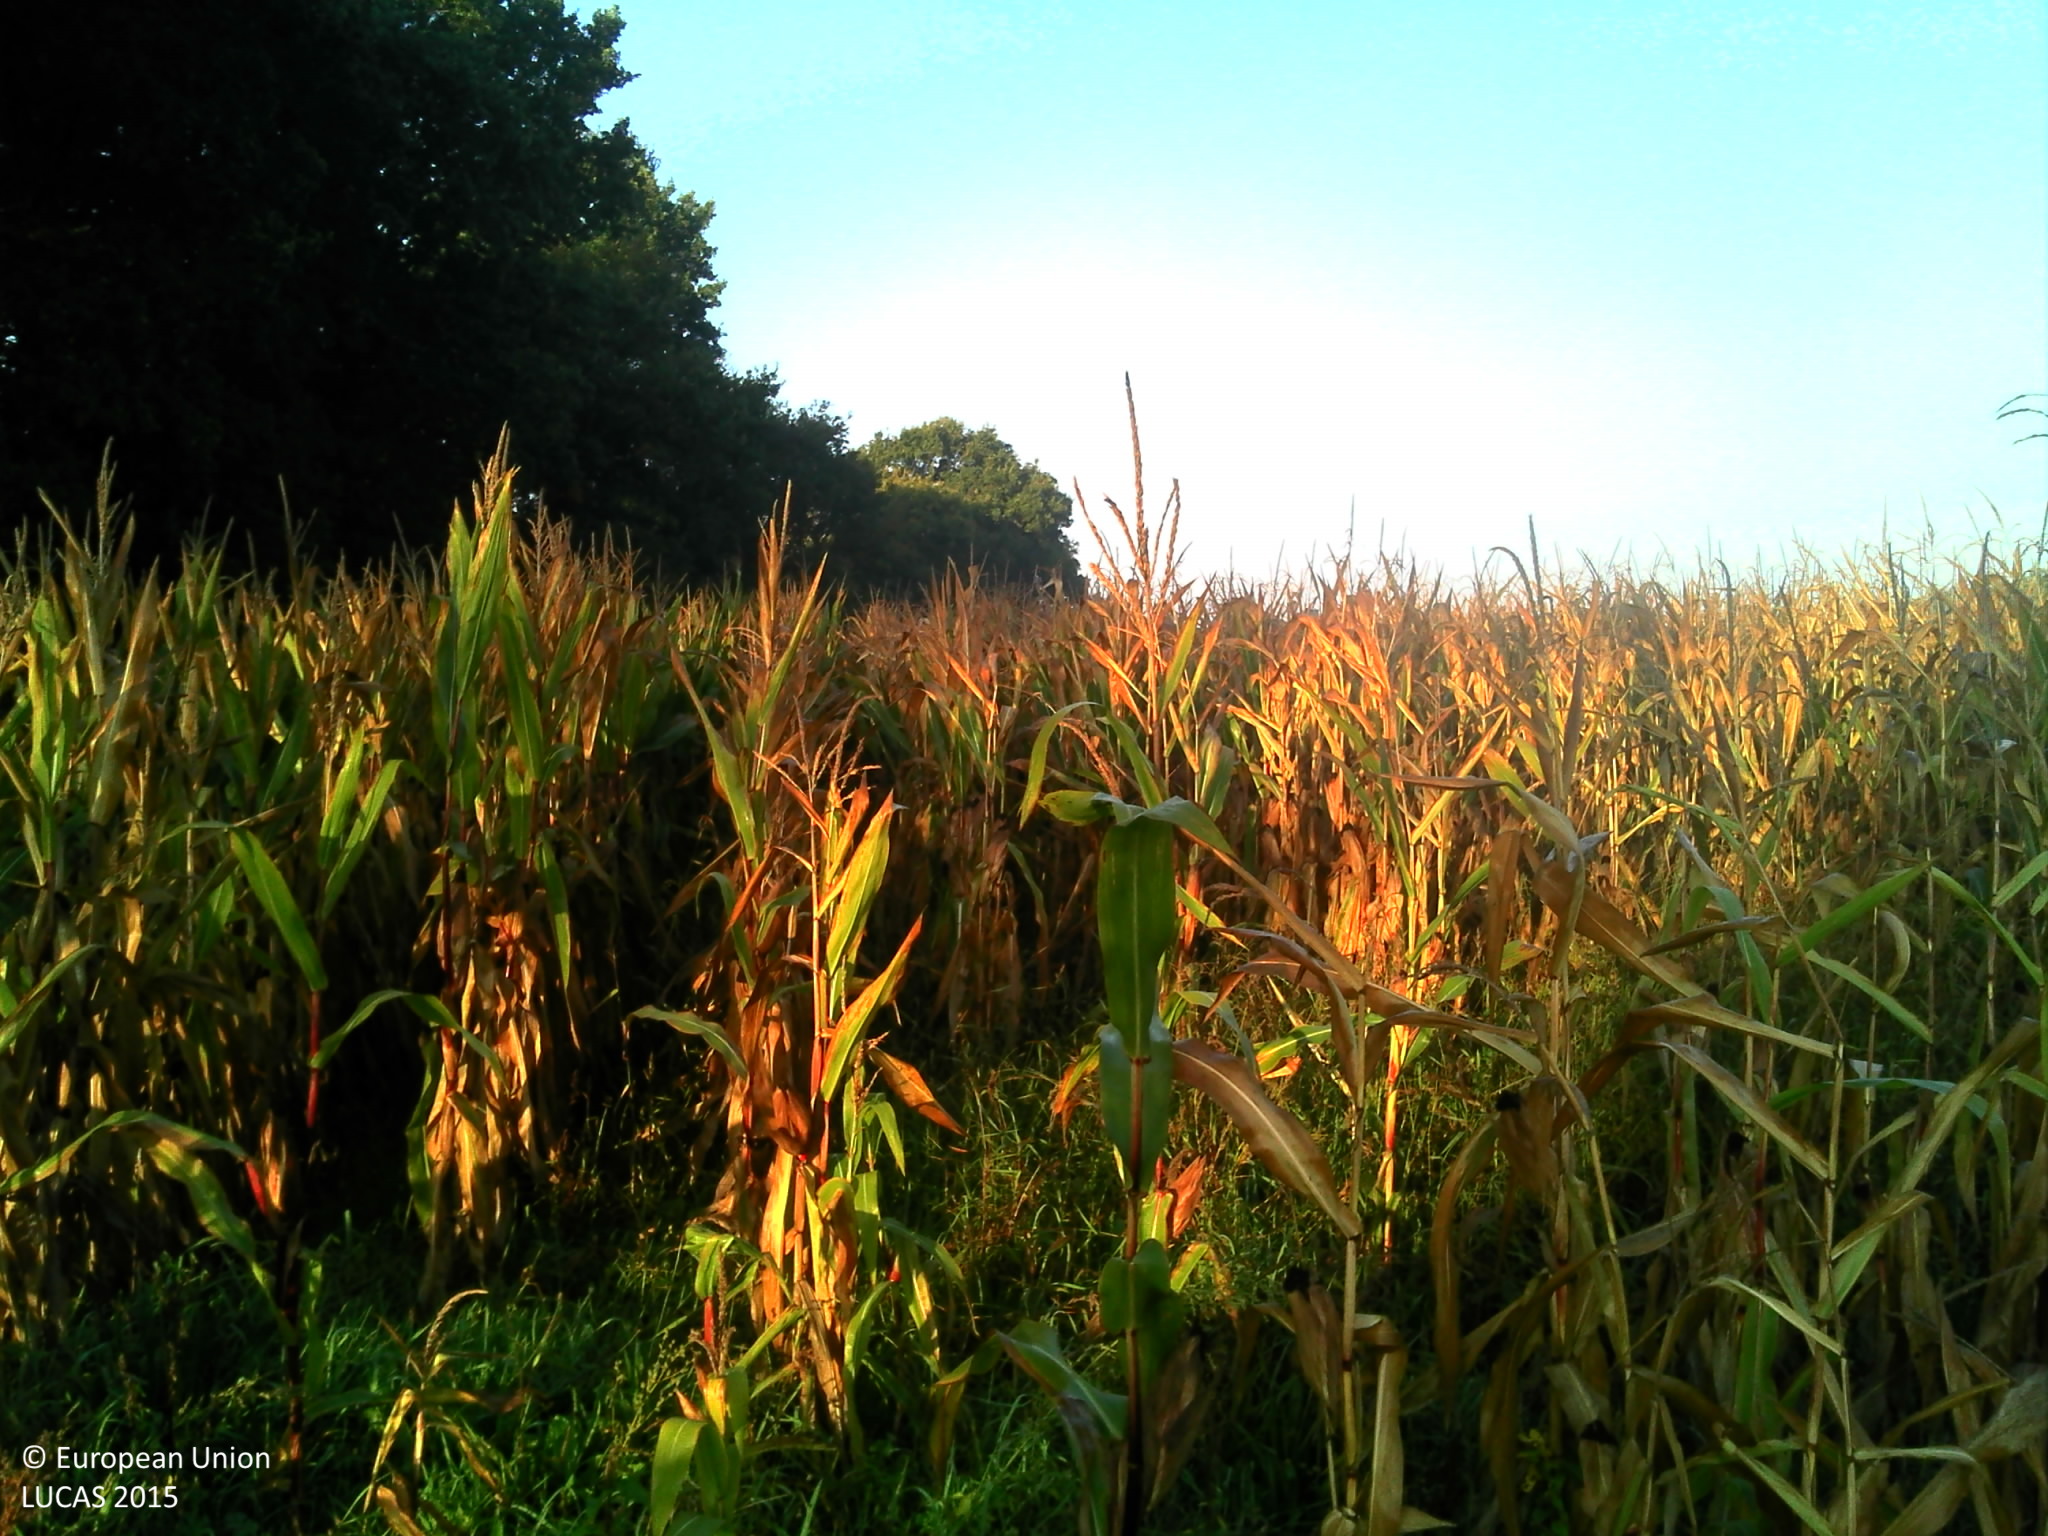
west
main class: Cropland
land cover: Maize
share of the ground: > 75 %
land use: Agriculture (excluding fallow land and kitchen gardens)
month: October
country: FR
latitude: 48.0616
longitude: -2.2808
